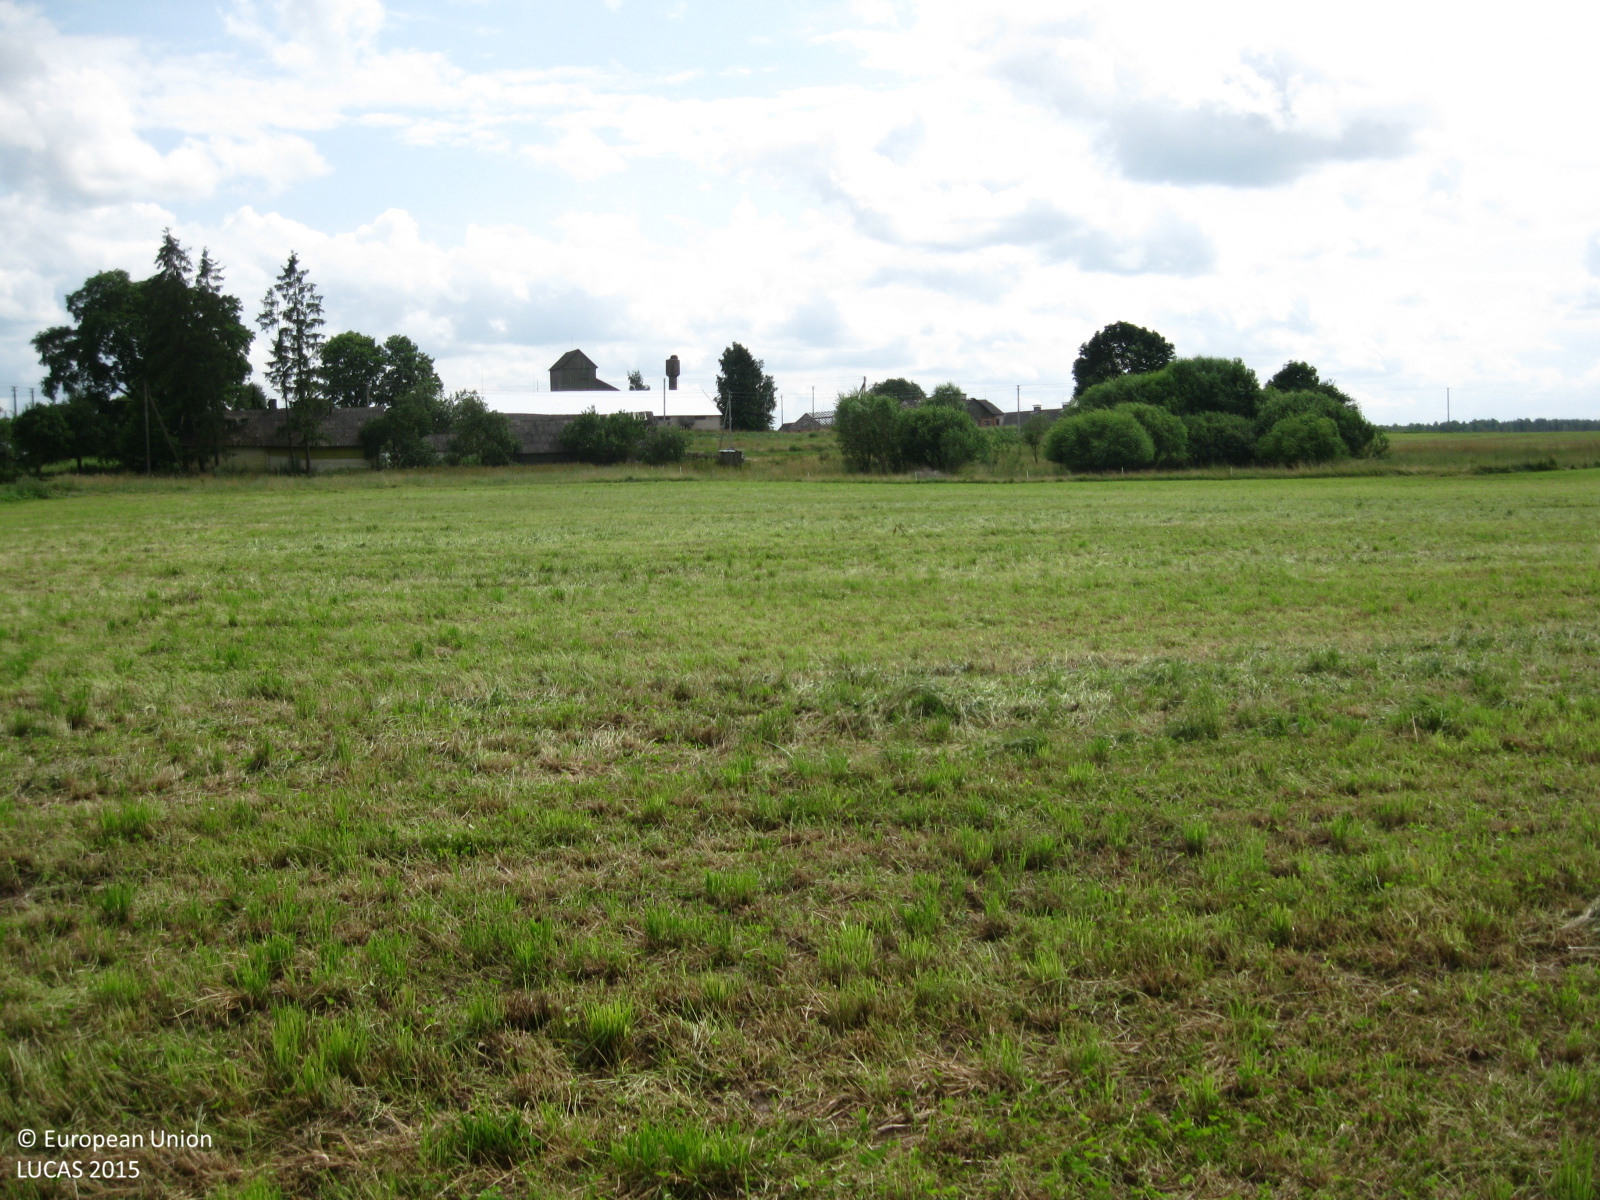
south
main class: Grassland
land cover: Grassland without tree/shrub cover
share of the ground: > 75 %
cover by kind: herbaceous plants 100 %
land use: Agriculture (excluding fallow land and kitchen gardens)
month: July
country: LT
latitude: 55.5924
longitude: 24.6867
